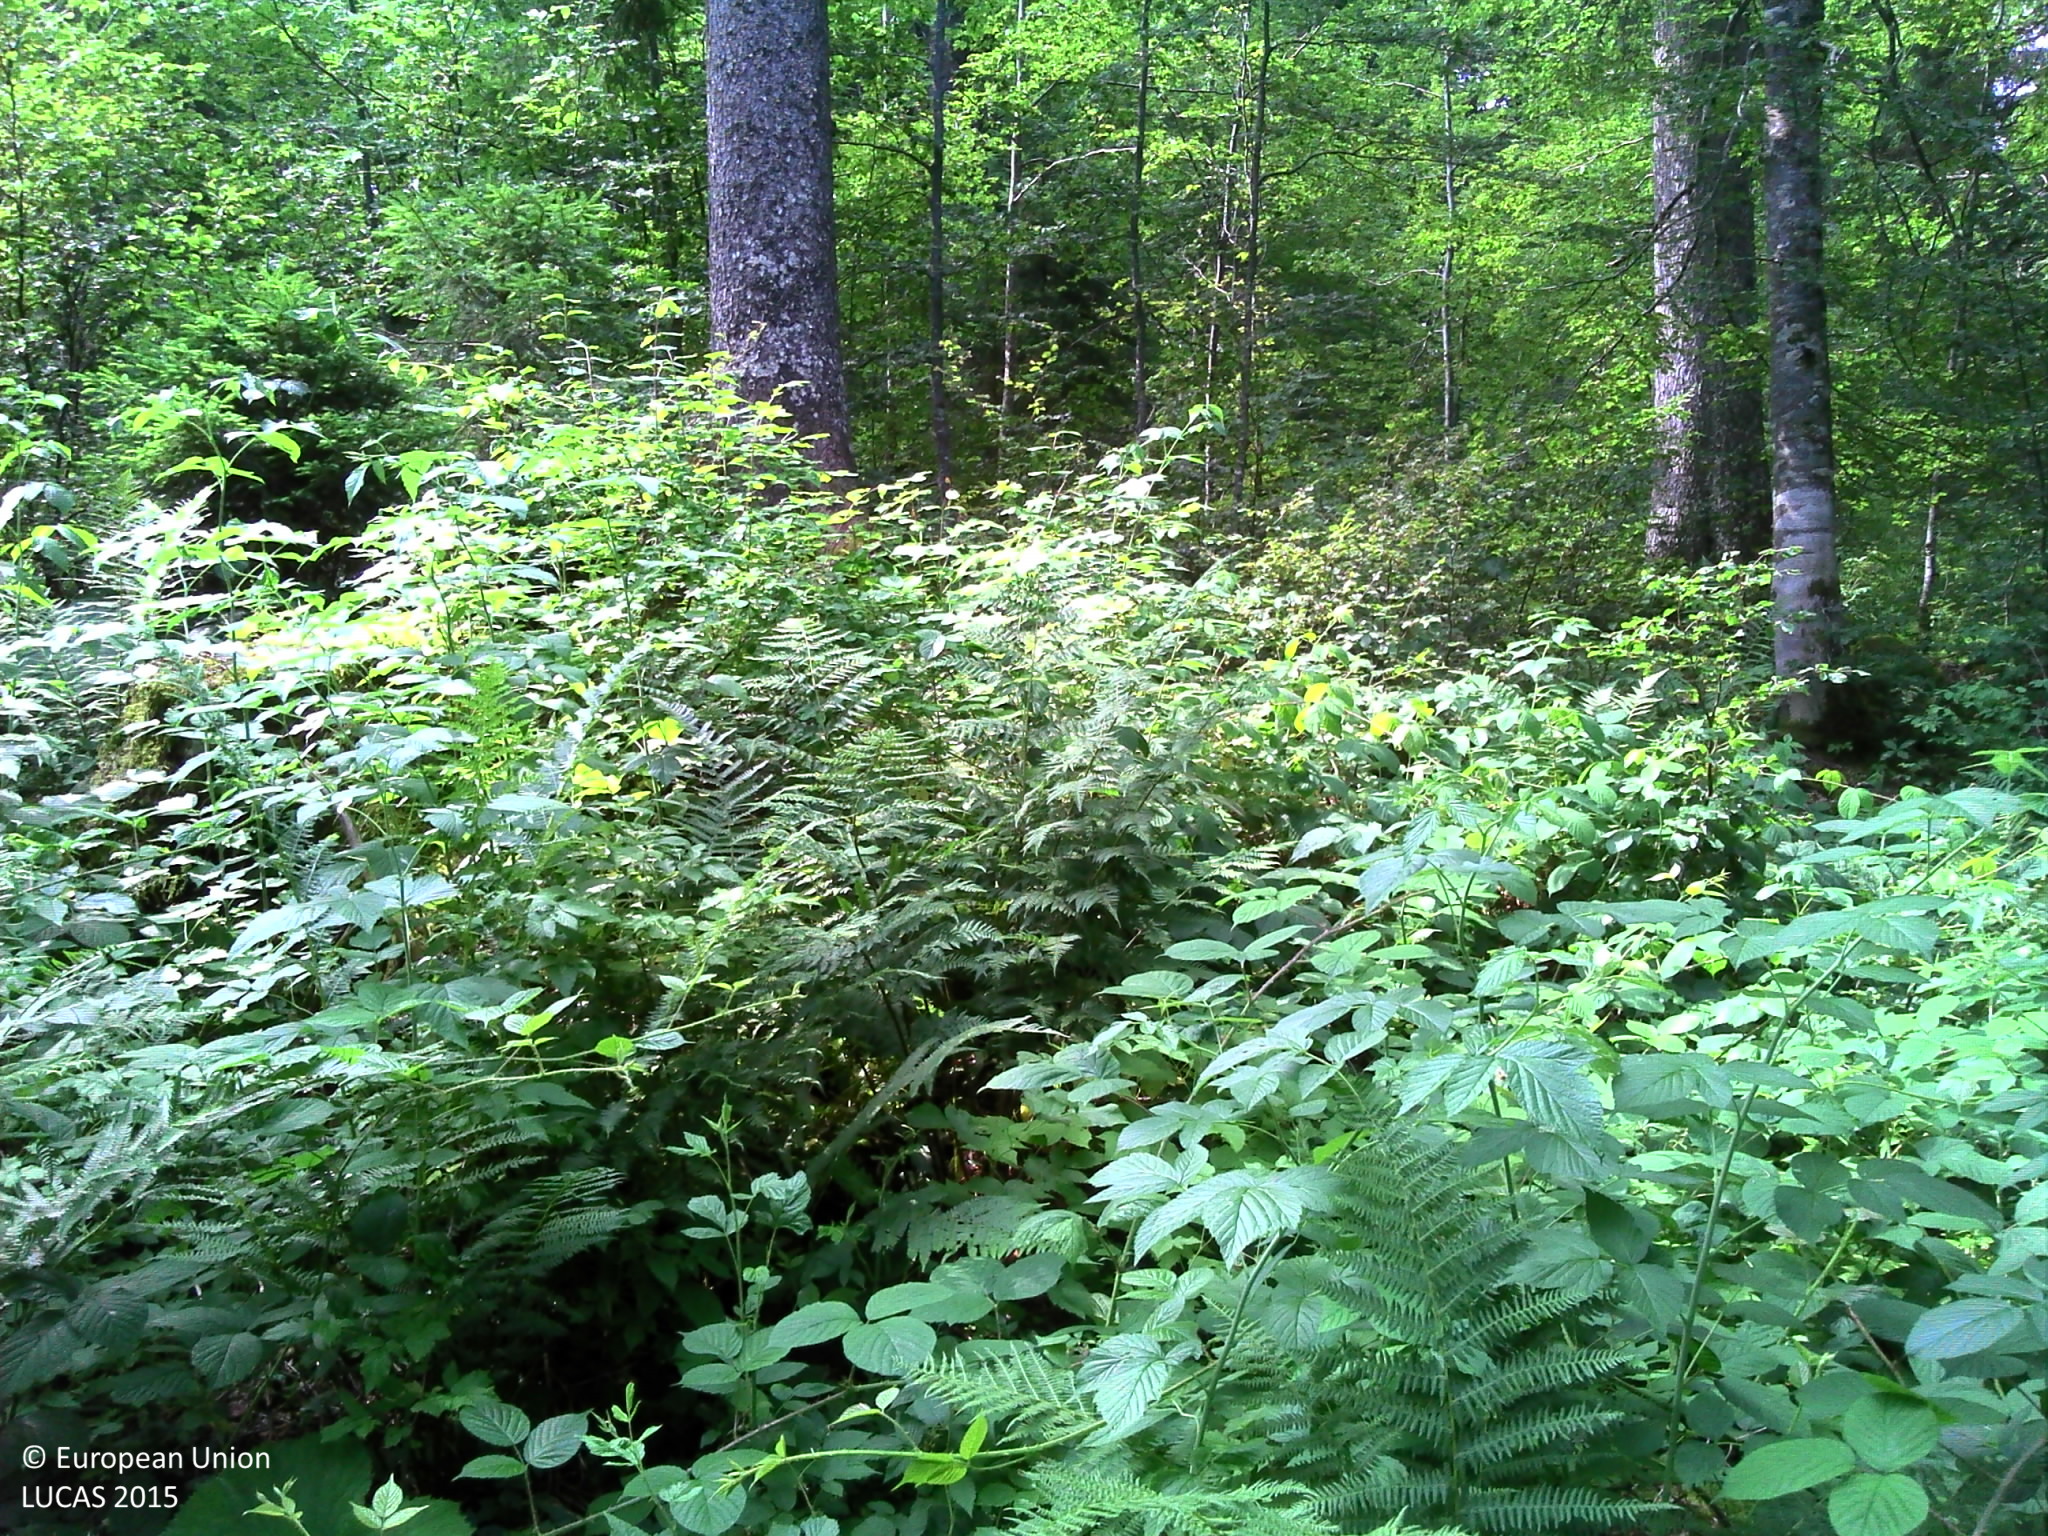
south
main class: Woodland
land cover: Spruce dominated mixed woodland
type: mountainous beech forest
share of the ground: 50 - 75 %
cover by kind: herbaceous plants 35 %, consolidated bare surface 20 %, coniferous forest trees 15 %, broadleaved forest trees 15 %, lichens and mosses 10 %, shrubs 5 %
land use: Forestry
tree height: > 5 m
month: July
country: FR
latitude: 46.5138
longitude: 6.0798
